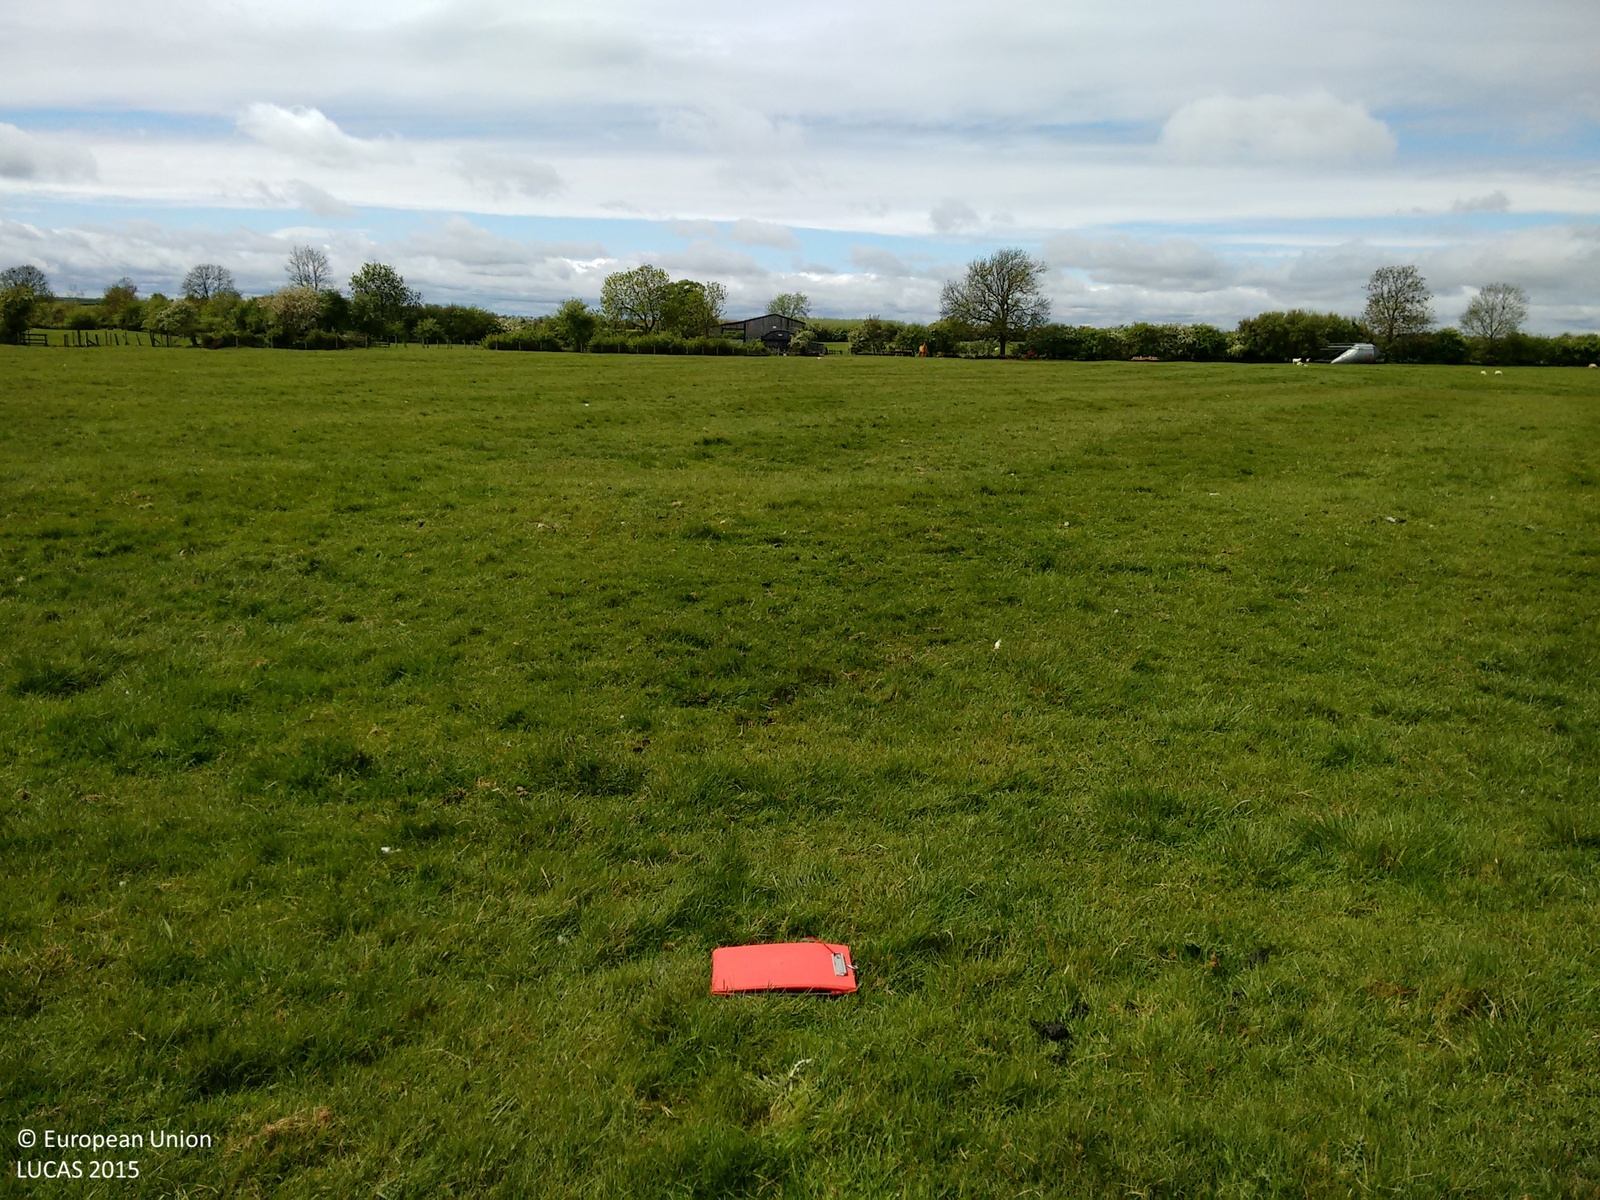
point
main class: Grassland
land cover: Grassland without tree/shrub cover
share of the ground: > 75 %
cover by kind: herbaceous plants 100 %
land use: Agriculture (excluding fallow land and kitchen gardens)
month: May
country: GB
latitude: 52.3139
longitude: -1.2397
